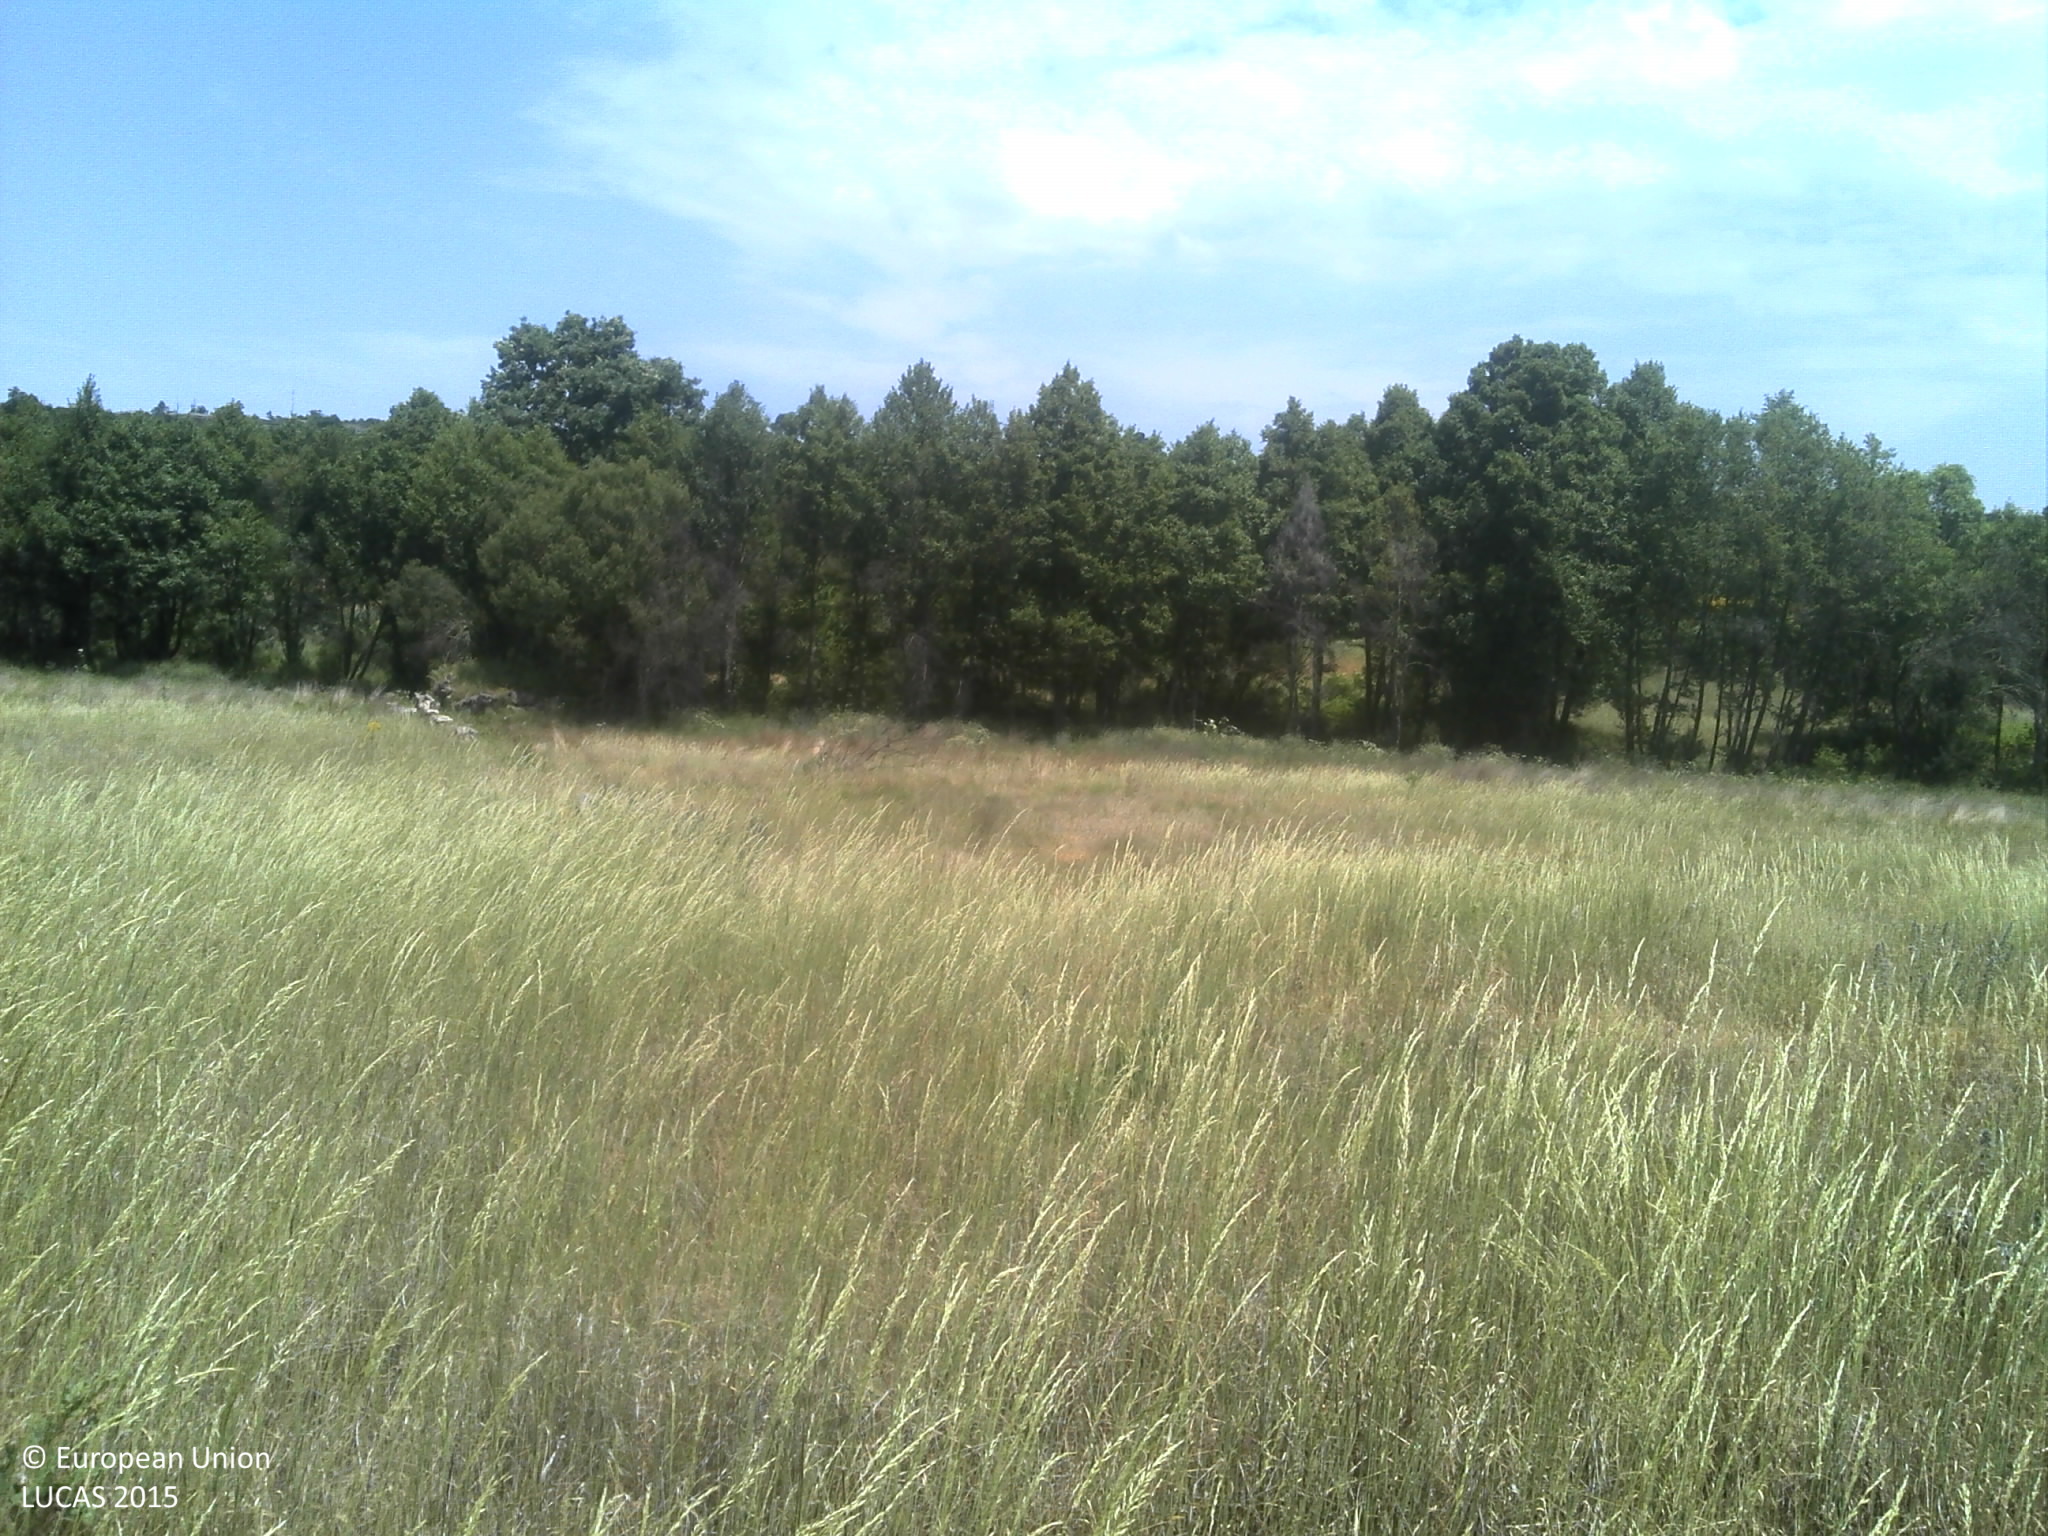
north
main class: Grassland
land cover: Grassland without tree/shrub cover
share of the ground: > 75 %
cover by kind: herbaceous plants 85 %, unconsolidated bare surface 15 %
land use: Agriculture (excluding fallow land and kitchen gardens)
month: June
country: PT
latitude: 40.4352
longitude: -7.1836
